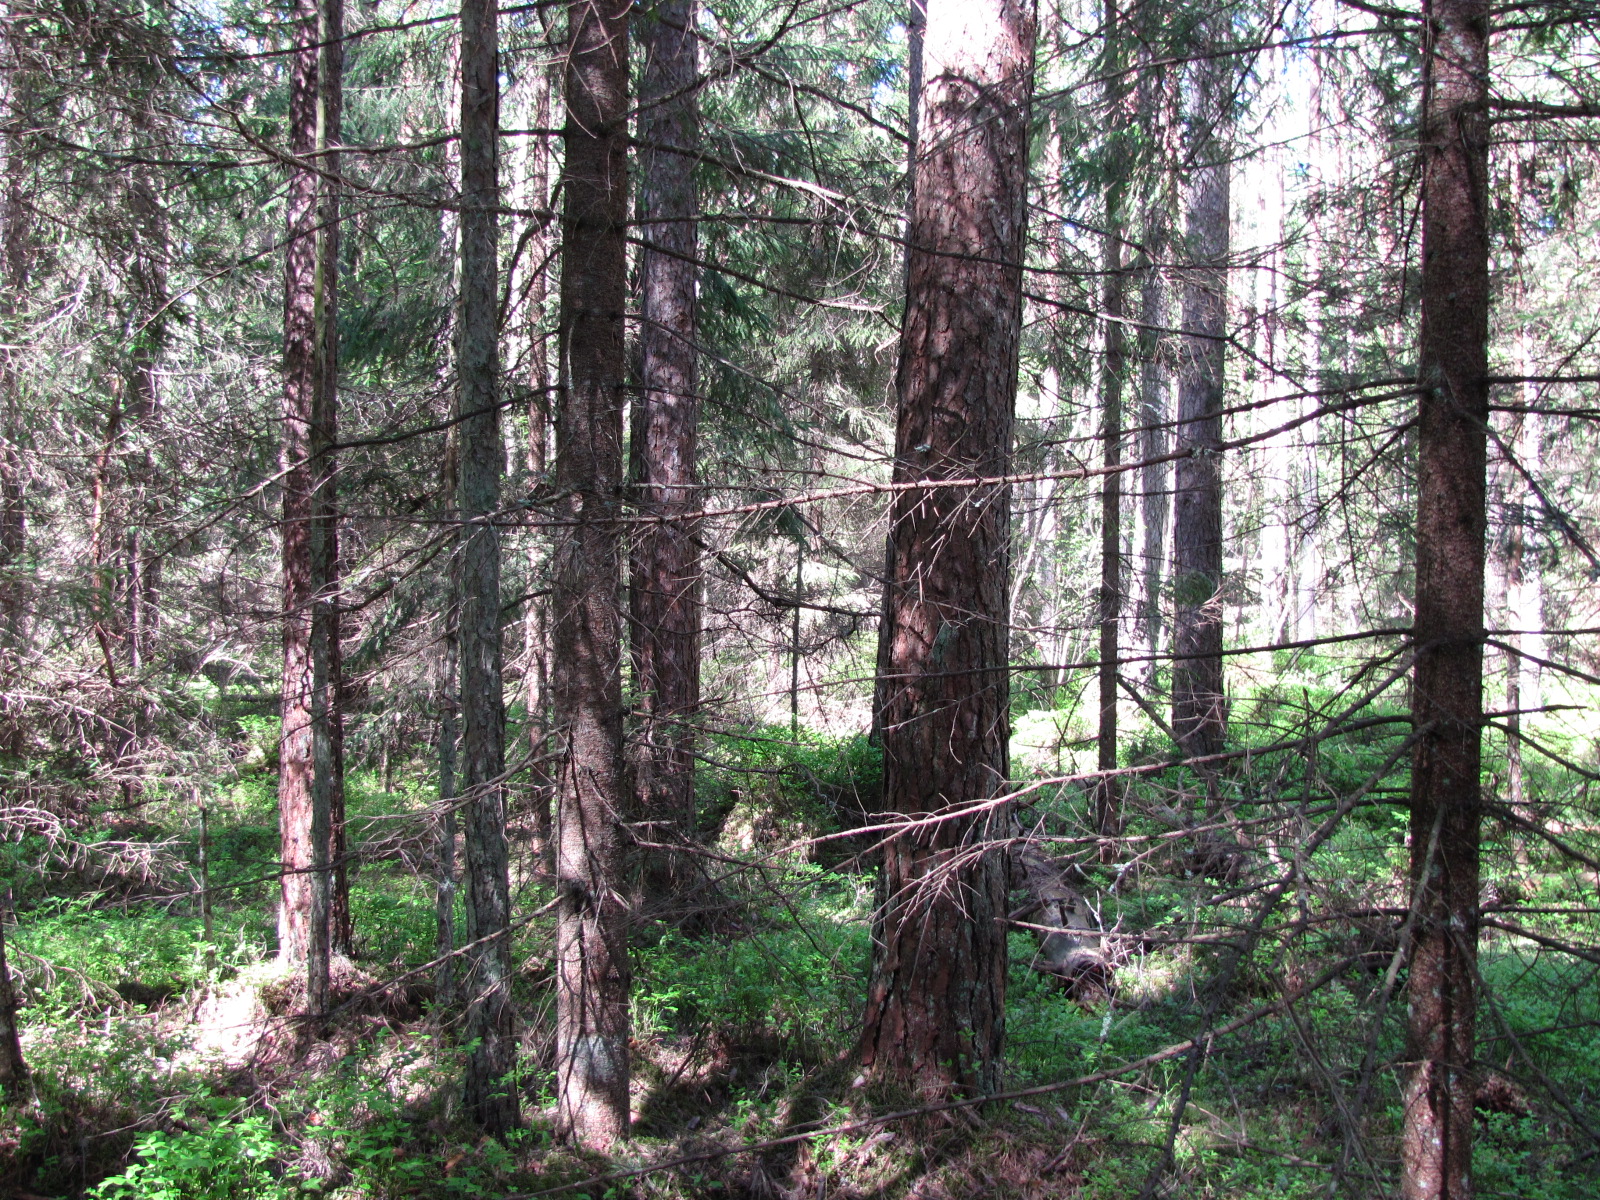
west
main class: Woodland
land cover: Other coniferous woodland
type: hemiboreal forest and nemoral coniferous forest and mixed broadleaved-coniferous forest
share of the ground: > 75 %
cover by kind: coniferous forest trees 100 %
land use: Forestry
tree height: > 5 m
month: May
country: LV
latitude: 56.6690
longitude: 24.0704
